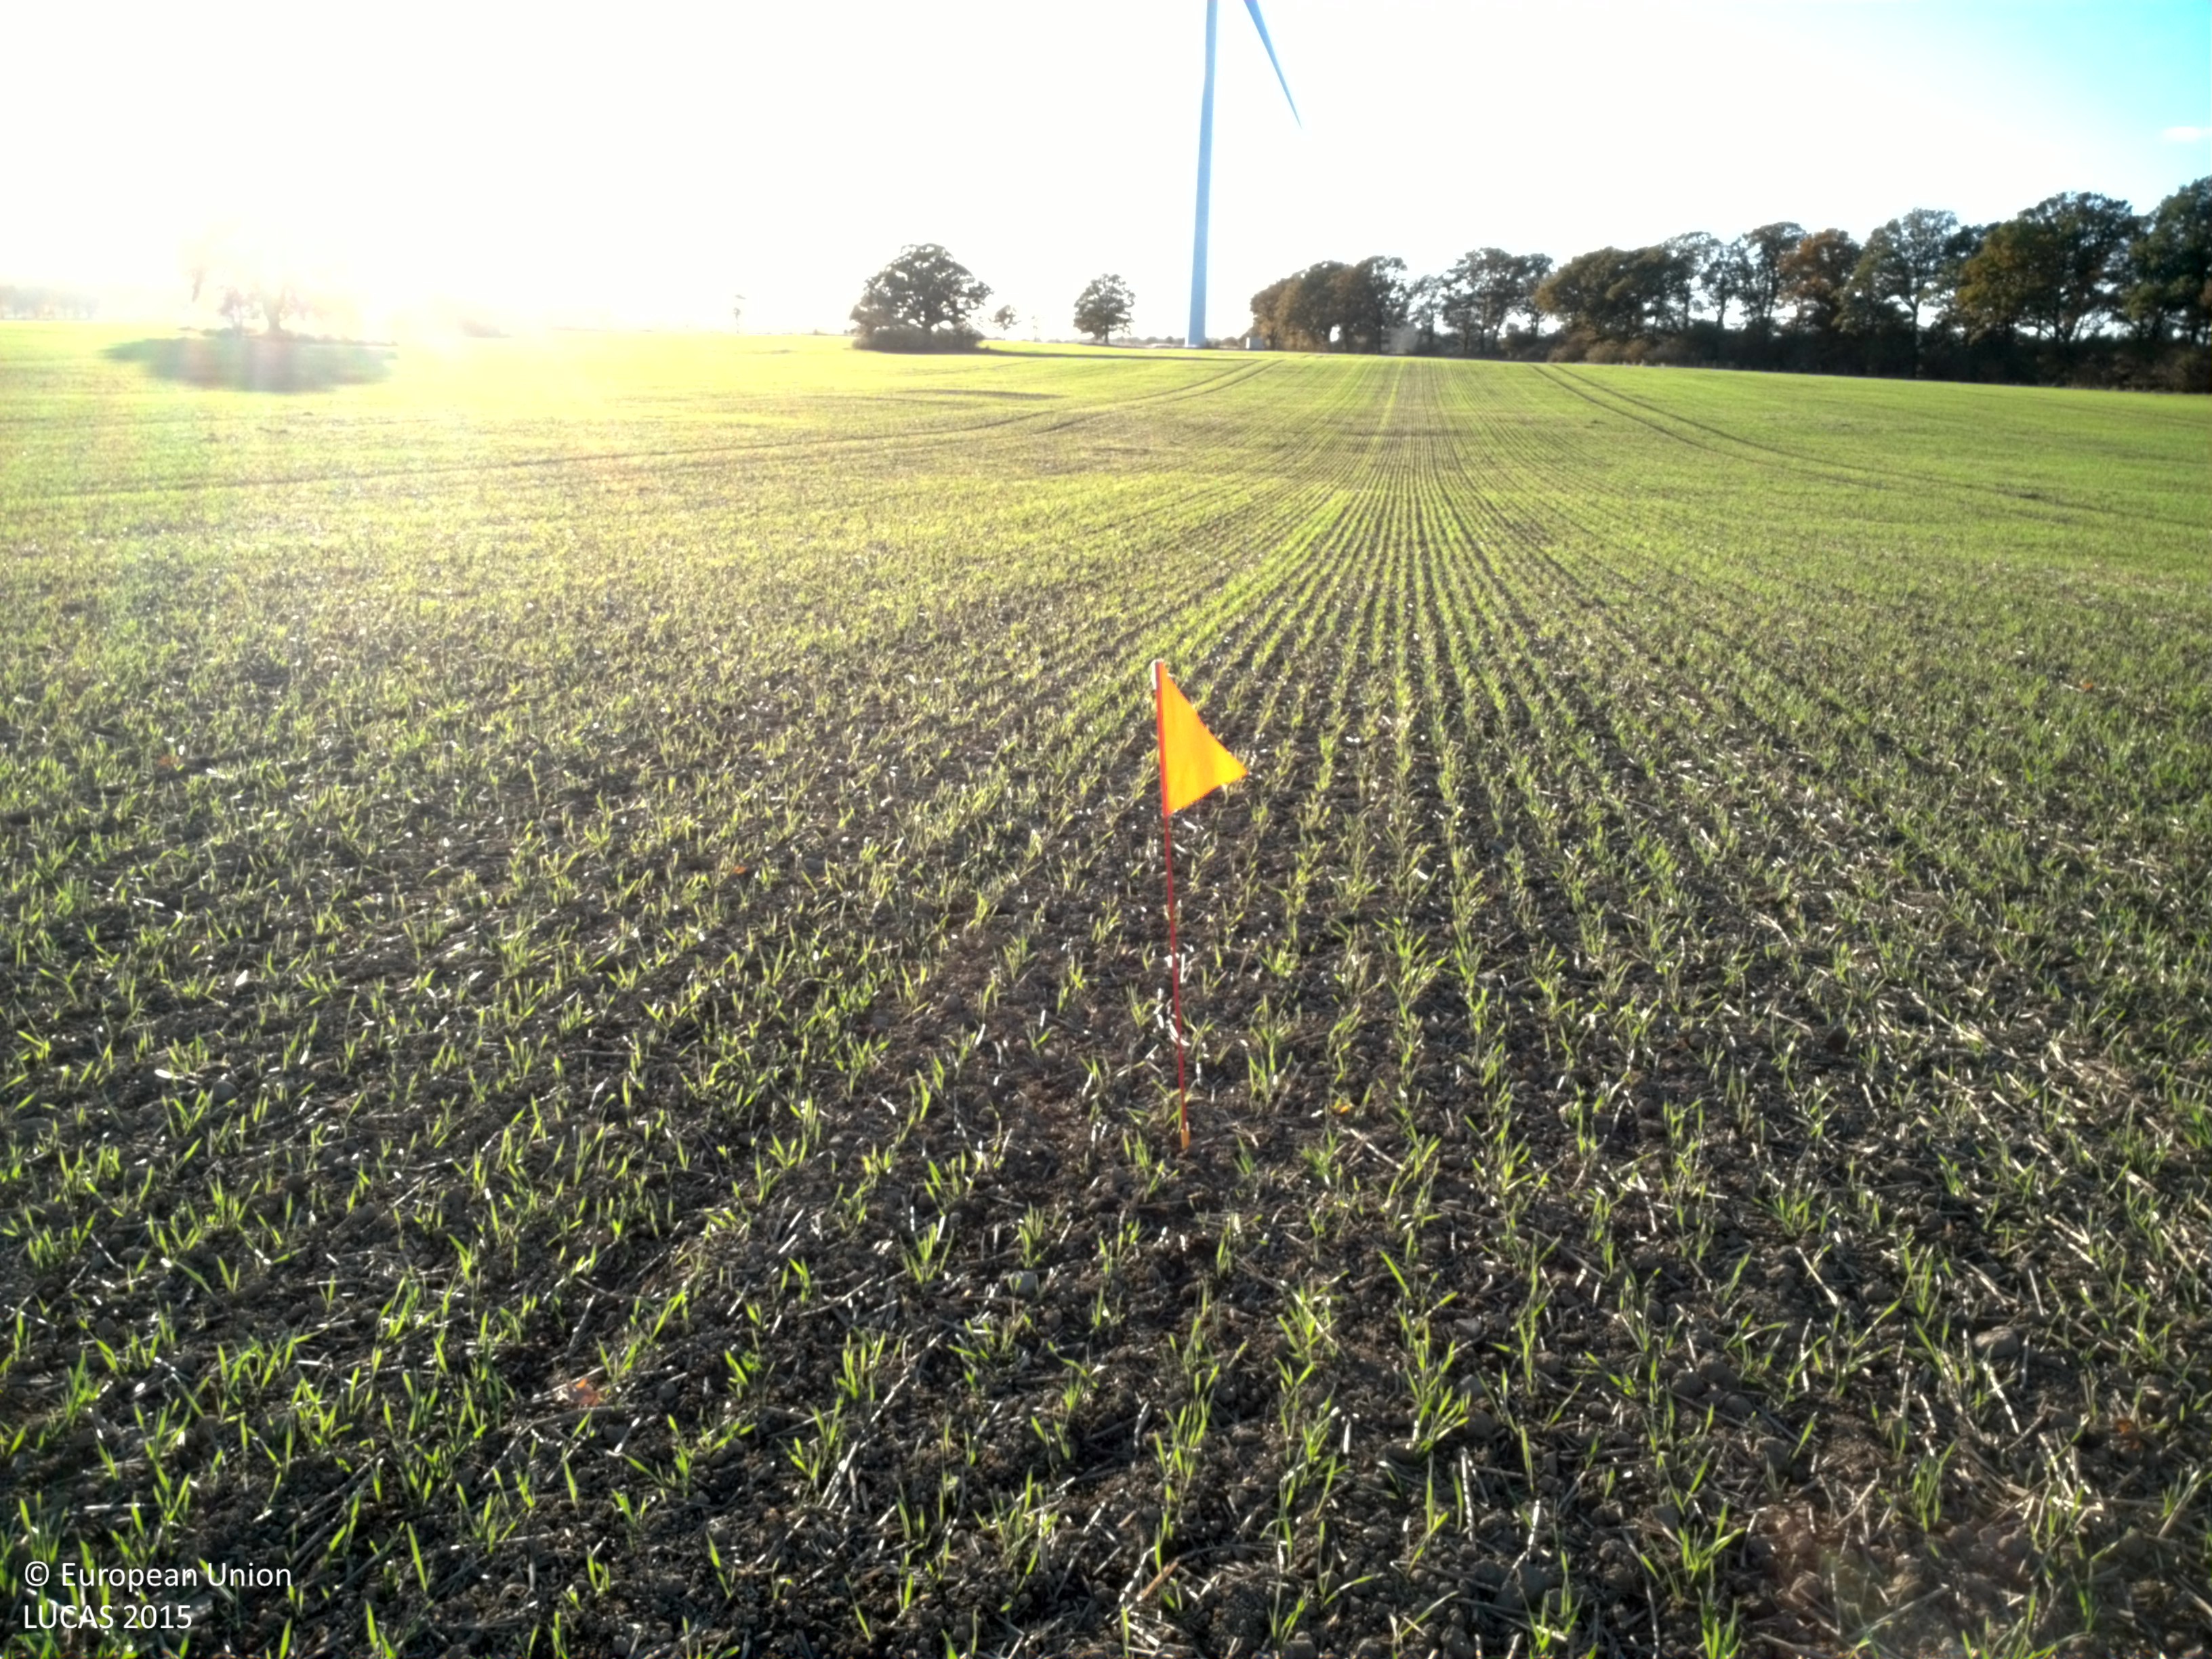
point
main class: Cropland
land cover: Common wheat
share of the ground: < 10 %
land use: Agriculture (excluding fallow land and kitchen gardens)
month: October
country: SE
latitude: 55.9535
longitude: 13.0566
